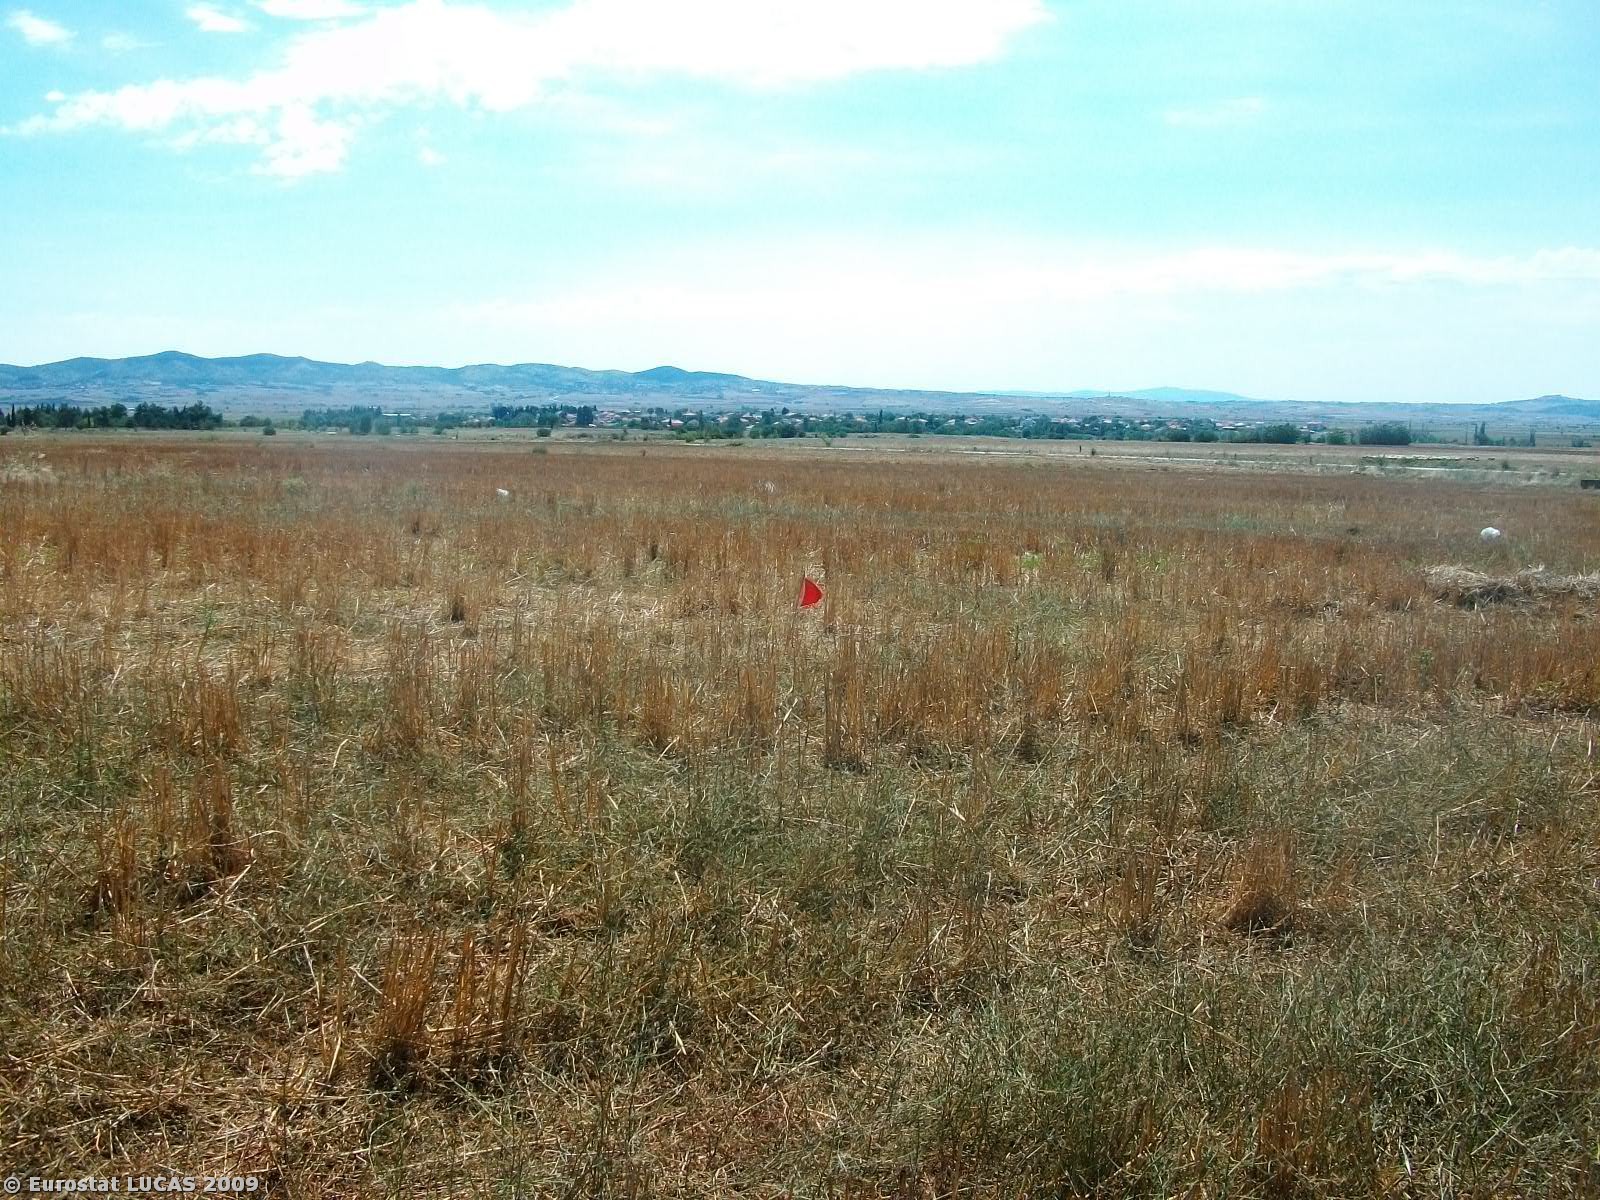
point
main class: Cropland
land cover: Barley
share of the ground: < 10 %
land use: Agriculture (excluding fallow land and kitchen gardens)
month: July
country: GR
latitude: 41.0942
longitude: 22.7610
